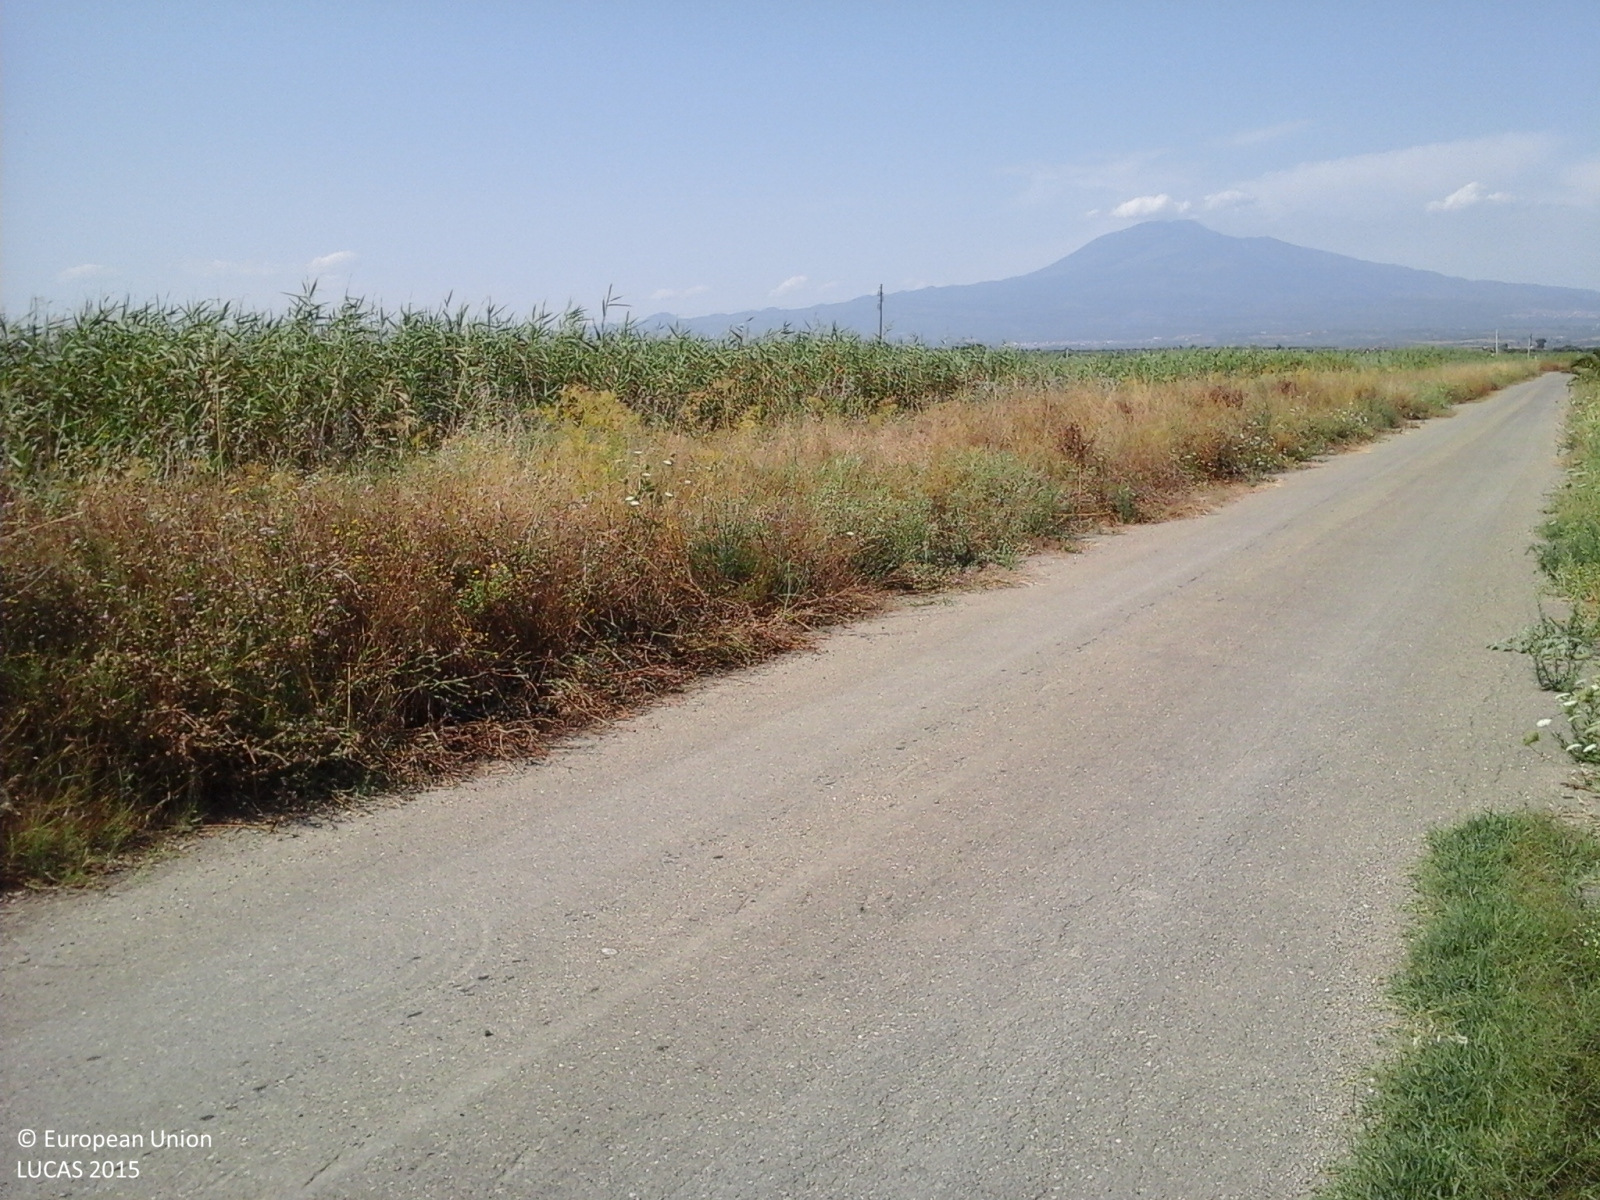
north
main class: Cropland
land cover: Oranges
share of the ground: > 75 %
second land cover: Spontaneously vegetated surfaces
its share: > 75 %
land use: Agriculture (excluding fallow land and kitchen gardens)
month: June
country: IT
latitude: 37.4415
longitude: 14.8585
